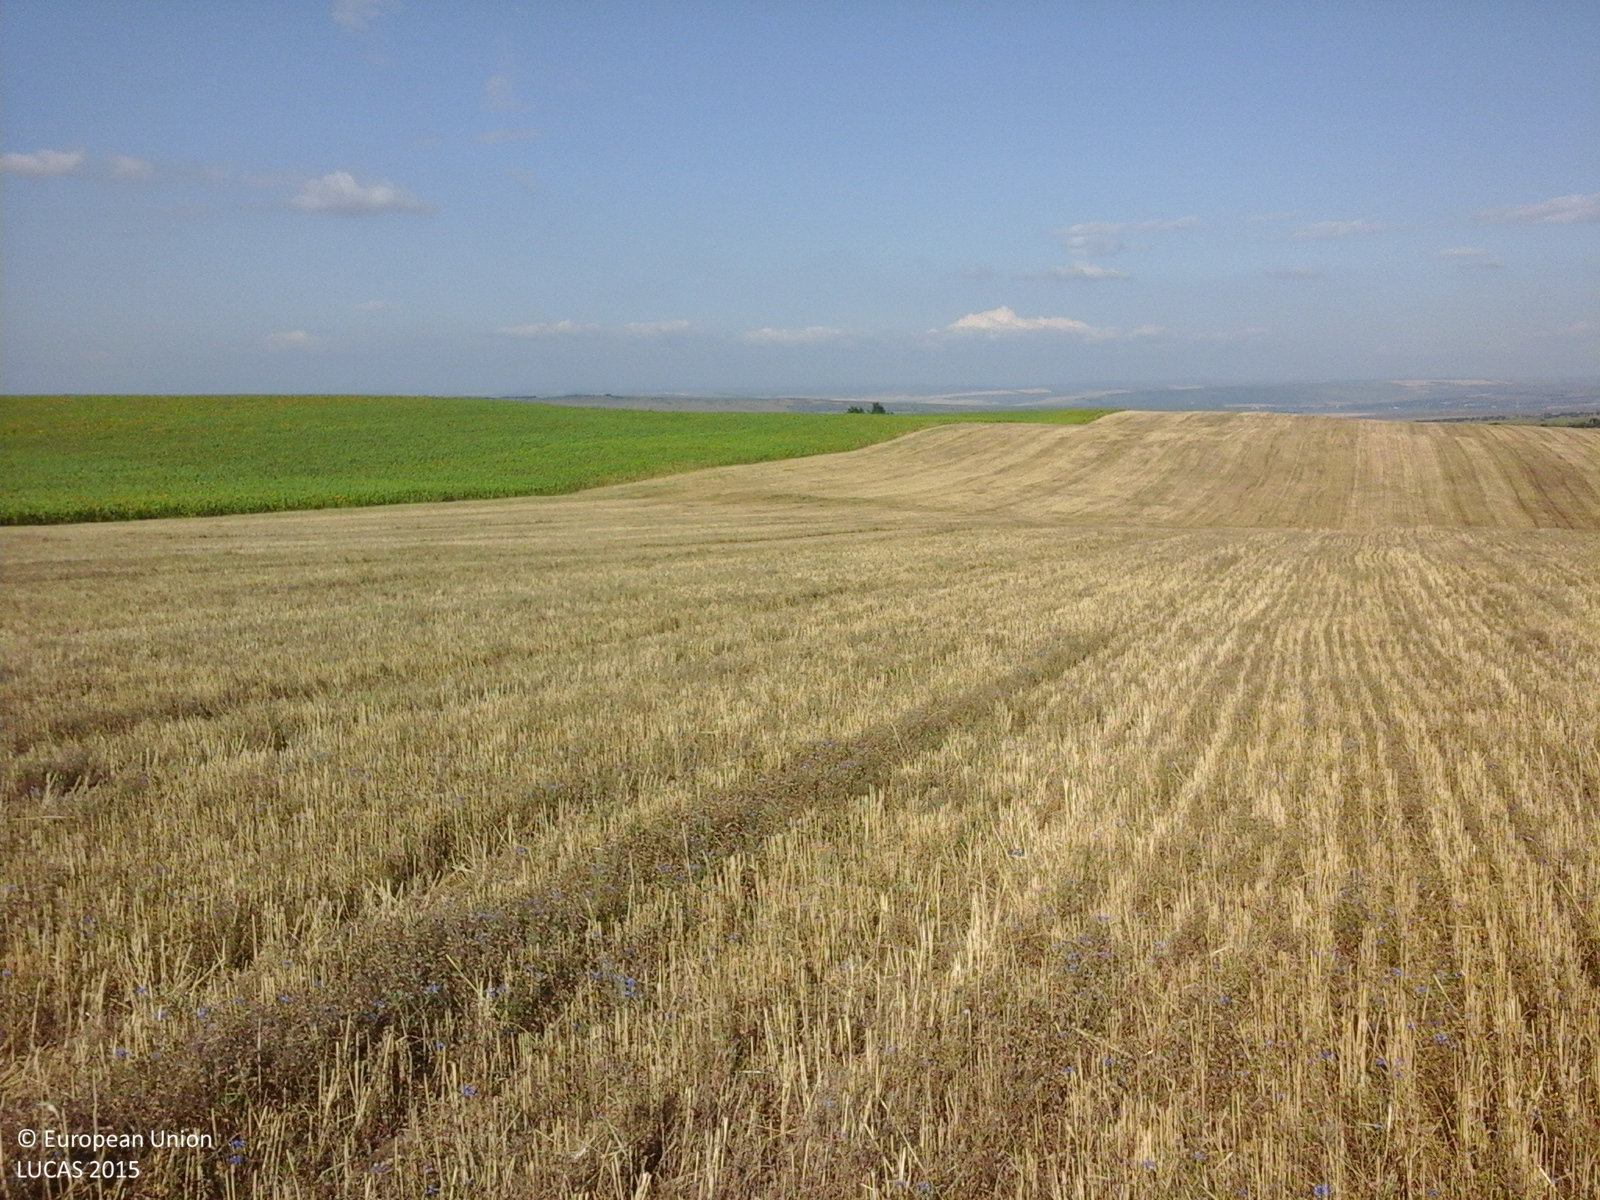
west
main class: Cropland
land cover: Common wheat
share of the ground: > 75 %
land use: Agriculture (excluding fallow land and kitchen gardens)
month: July
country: RO
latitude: 46.0956
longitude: 27.6916
